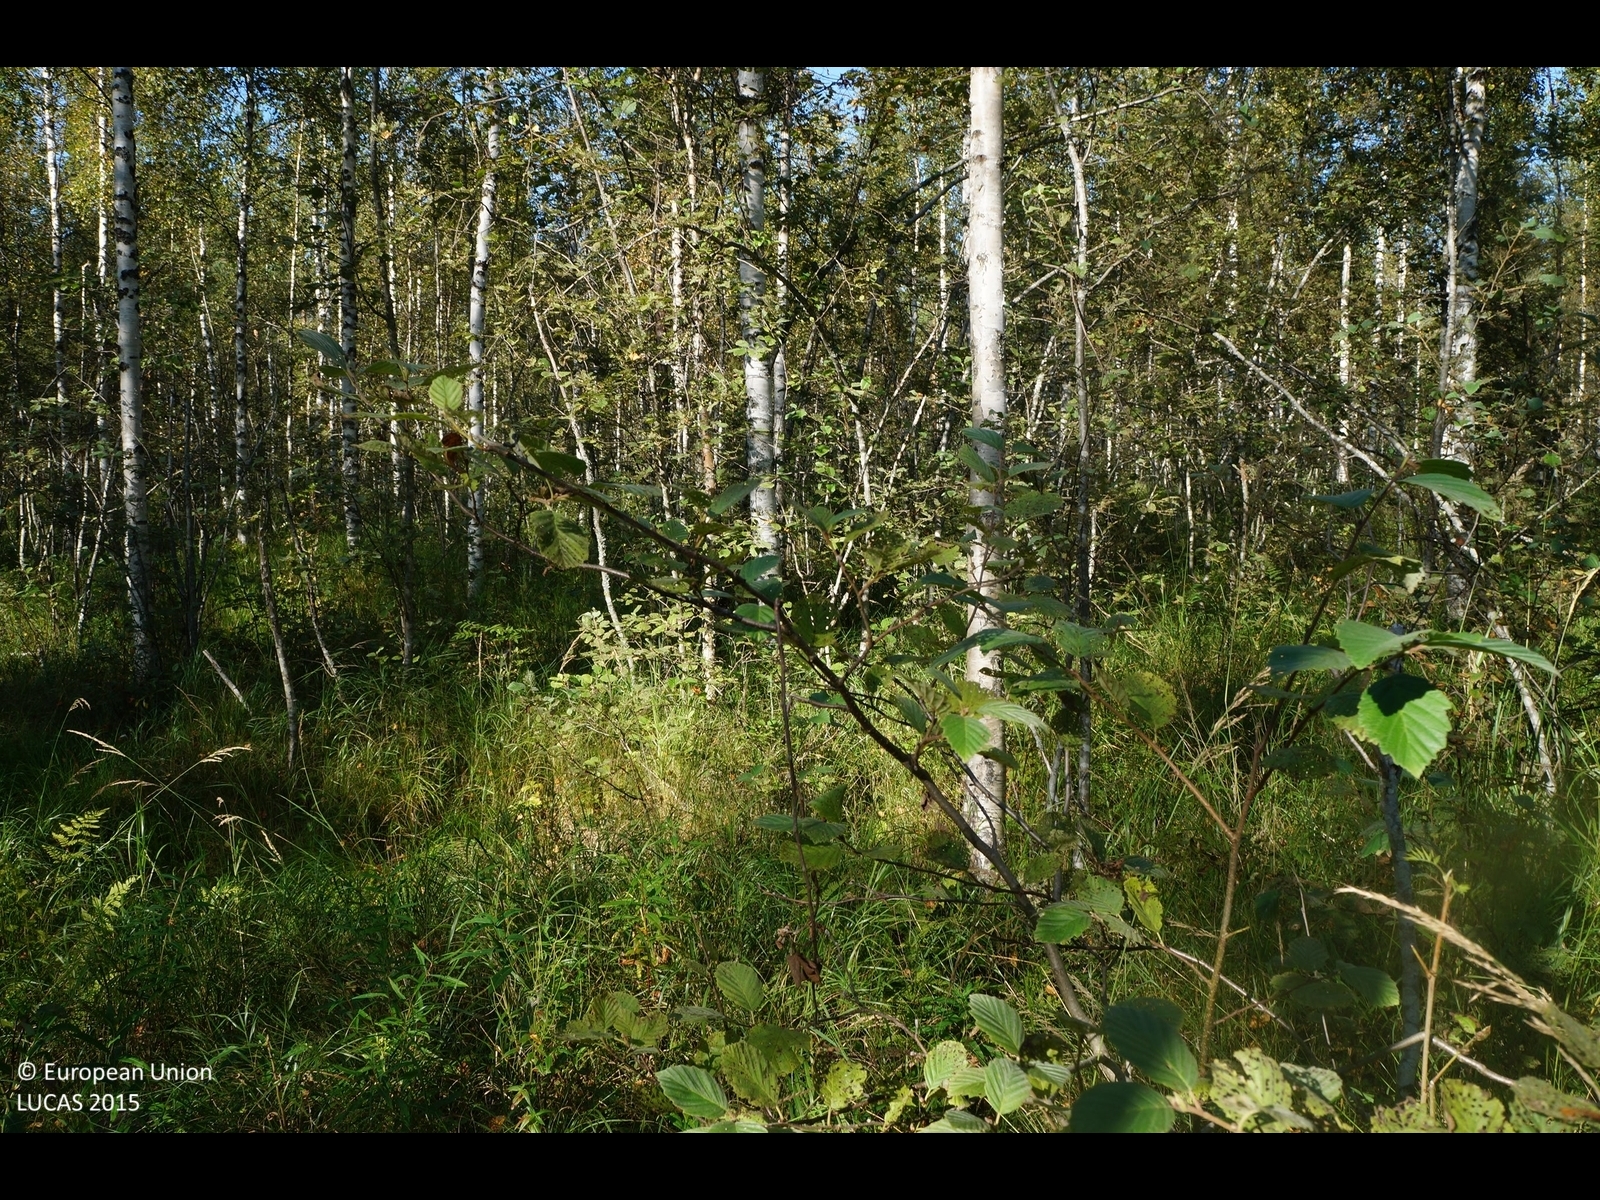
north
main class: Woodland
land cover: Broadleaved woodland
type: non-riverine alder, birch or aspen forest
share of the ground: 25 - 50 %
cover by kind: broadleaved forest trees 40 %, herbaceous plants 40 %, shrubs 20 %
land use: Forestry
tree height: > 5 m
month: August
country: FI
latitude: 64.0861
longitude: 24.9937
